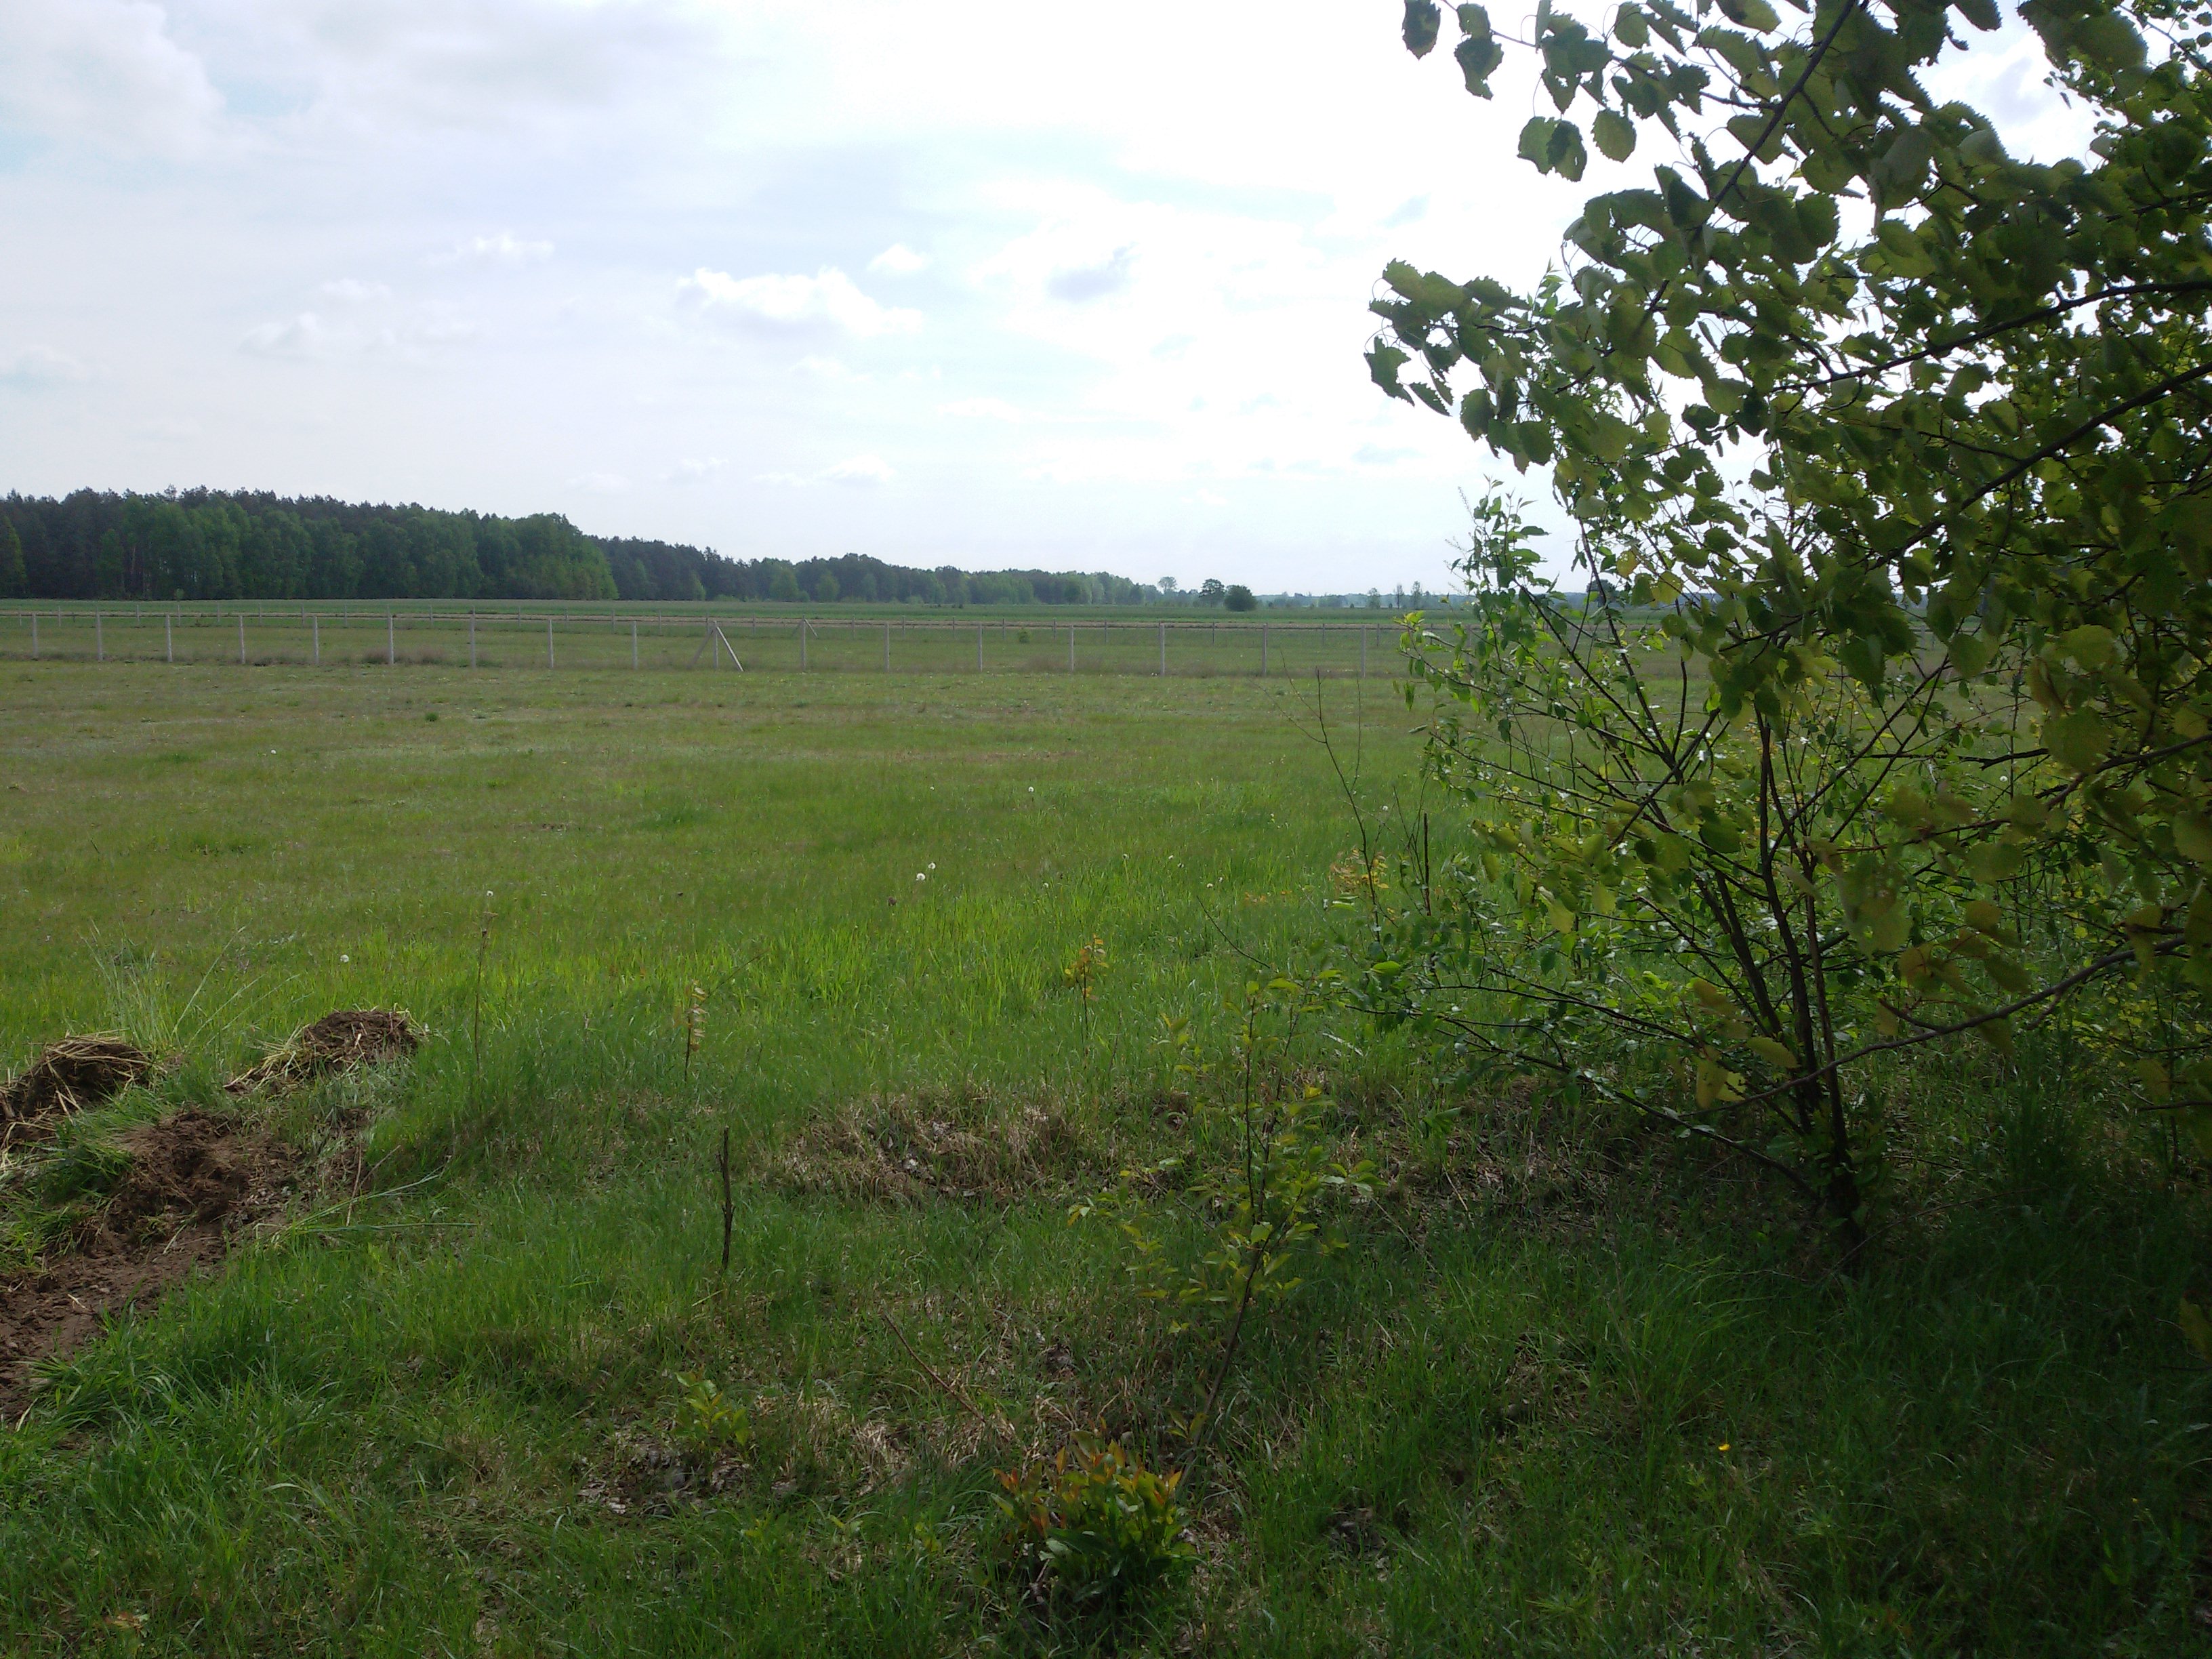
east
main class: Woodland
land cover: Broadleaved woodland
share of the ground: 25 - 50 %
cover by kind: unconsolidated bare surface 50 %, broadleaved forest trees 40 %, herbaceous plants 10 %
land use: Semi-natural and natural areas not in use
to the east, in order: Broadleaved woodland; Grassland without tree/shrub cover; Fences; Grassland without tree/shrub cover; Fences; Grassland without tree/shrub cover; Fences; Grass margins; Rye; Tracks; Maize; Grass margins; Maize
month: May
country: PL
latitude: 53.1672
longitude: 21.4329
